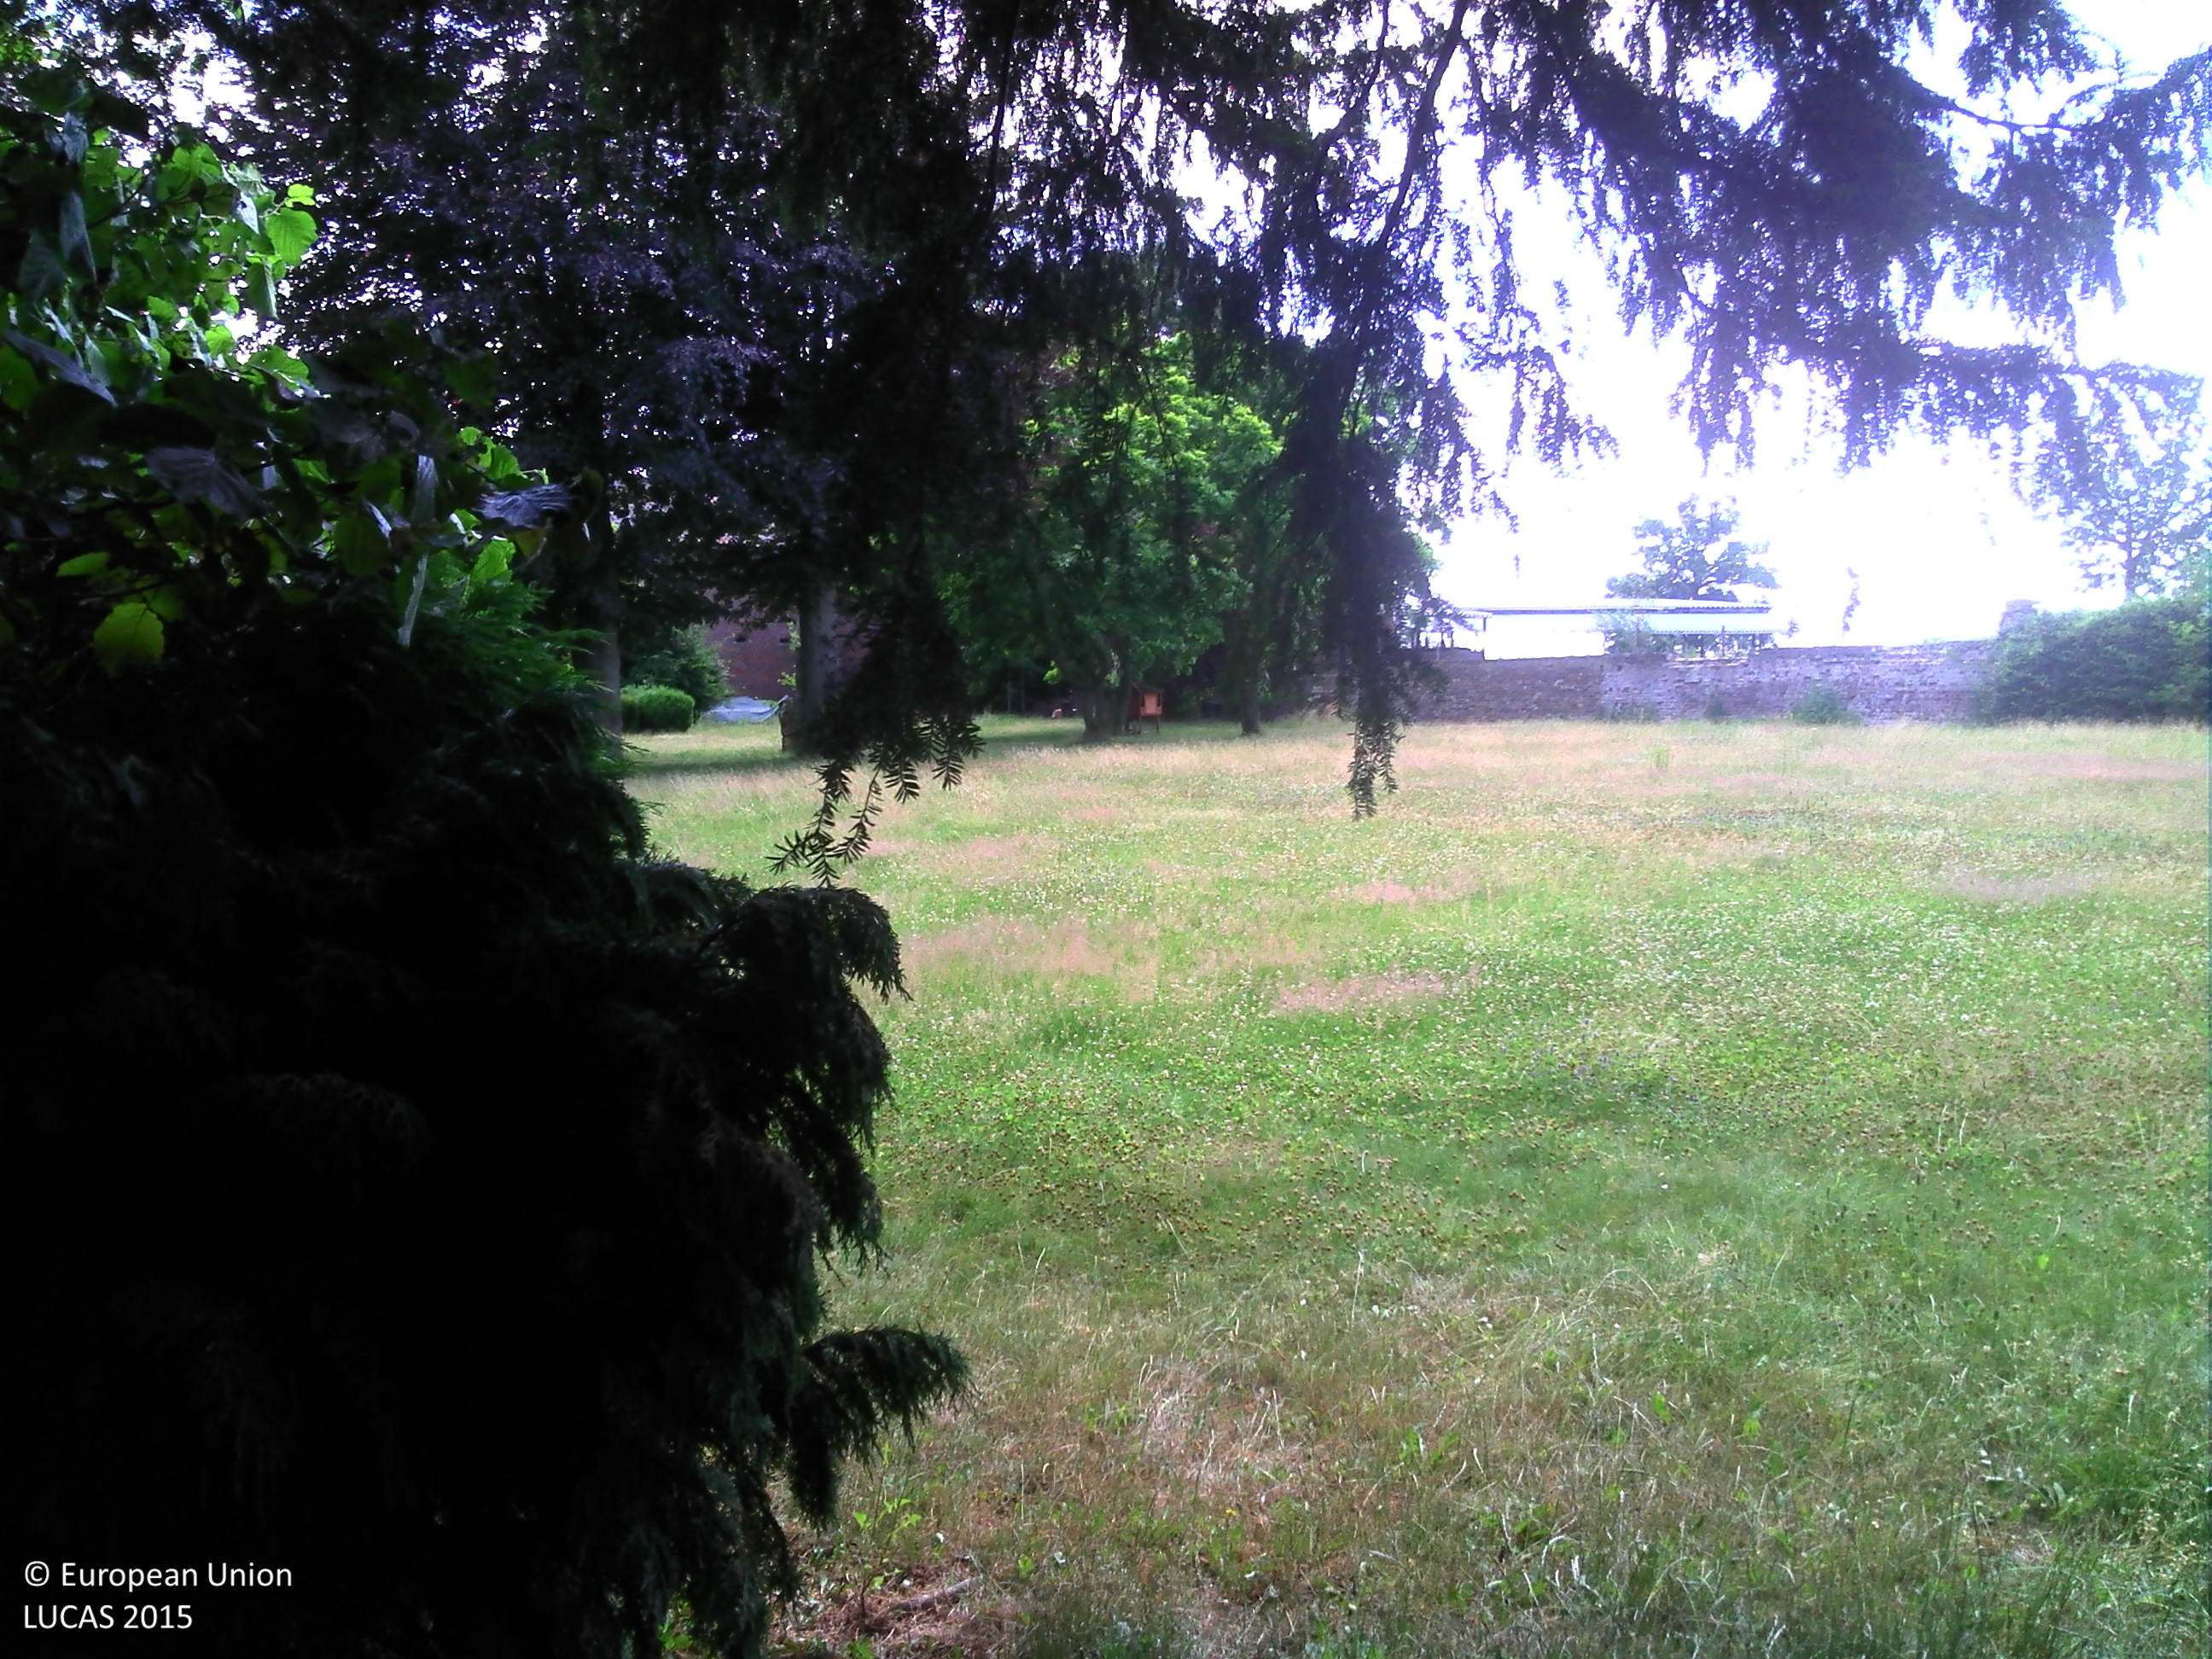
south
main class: Woodland
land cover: Spruce dominated mixed woodland
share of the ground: > 75 %
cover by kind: coniferous forest trees 75 %, broadleaved forest trees 25 %
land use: Residential
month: July
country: BE
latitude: 50.7708
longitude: 5.2759
